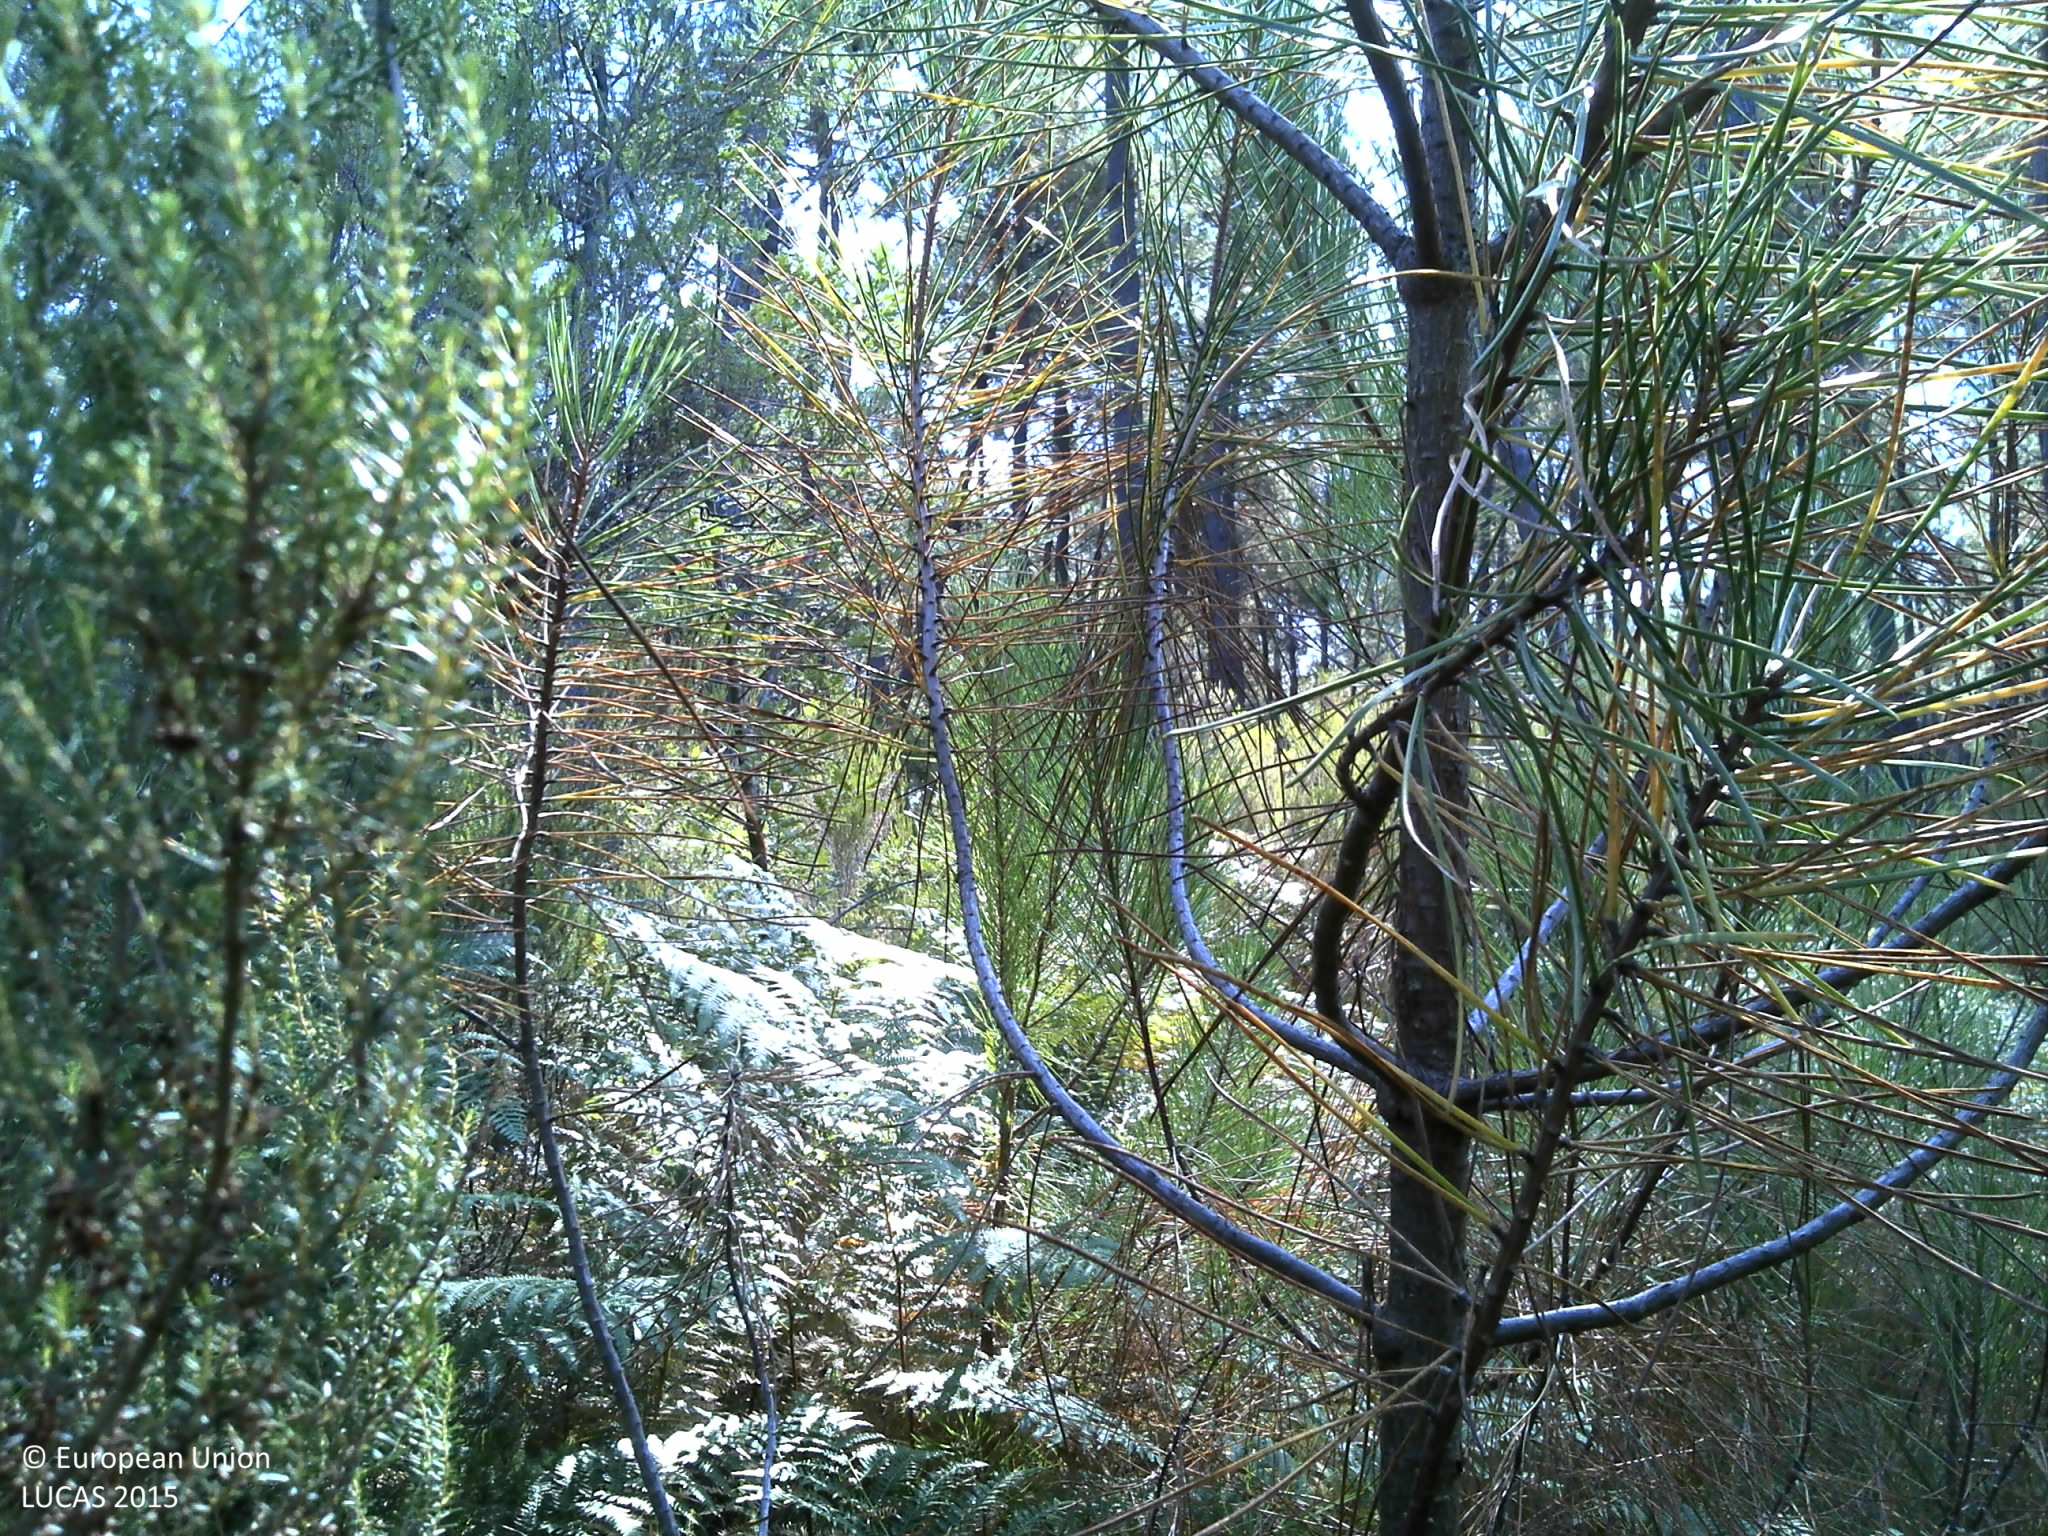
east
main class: Woodland
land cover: Pine dominated coniferous woodland
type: coniferous forest of the mediterranean region
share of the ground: > 75 %
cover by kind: coniferous forest trees 60 %, shrubs 30 %, herbaceous plants 5 %, lichens and mosses 5 %
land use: Forestry
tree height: > 5 m
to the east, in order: Pine dominated coniferous woodland
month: August
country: FR
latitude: 45.0569
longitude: -0.9826
